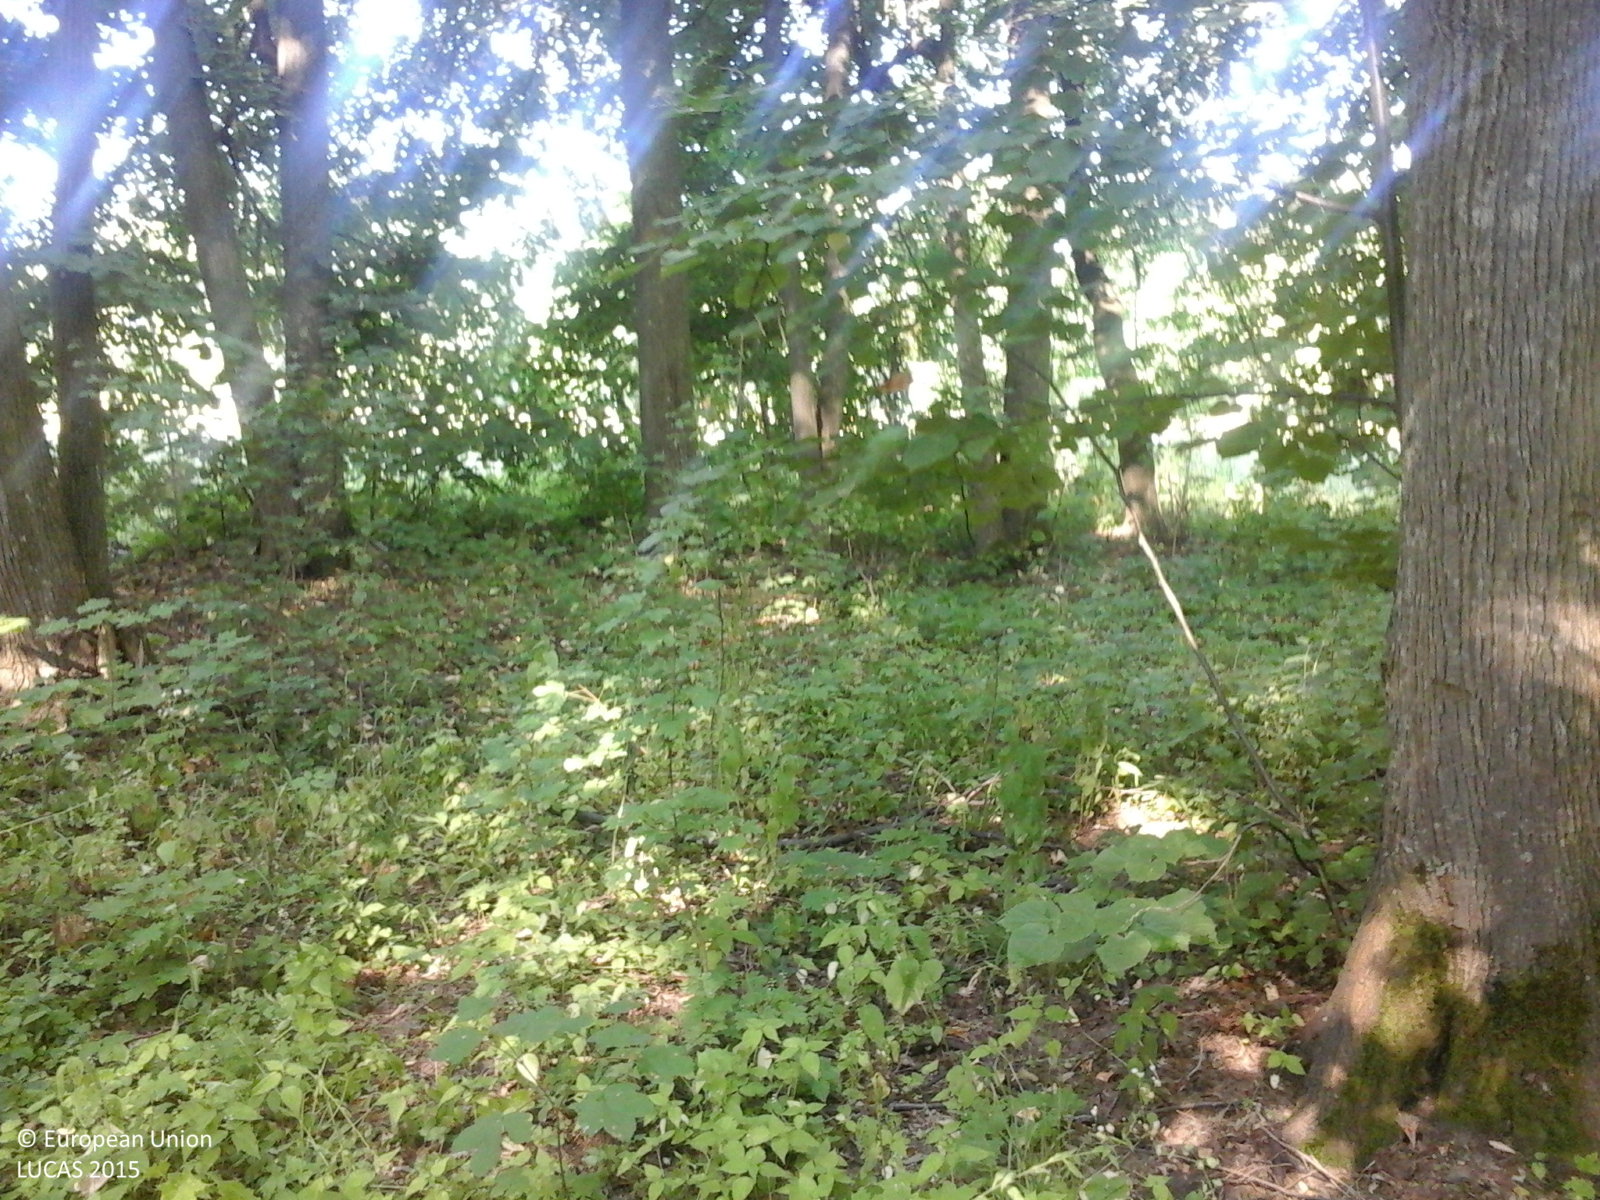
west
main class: Woodland
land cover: Broadleaved woodland
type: mesophytic deciduous forest
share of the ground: > 75 %
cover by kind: broadleaved forest trees 90 %, herbaceous plants 10 %
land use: Forestry
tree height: > 5 m
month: July
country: RO
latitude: 46.0540
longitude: 27.2778
